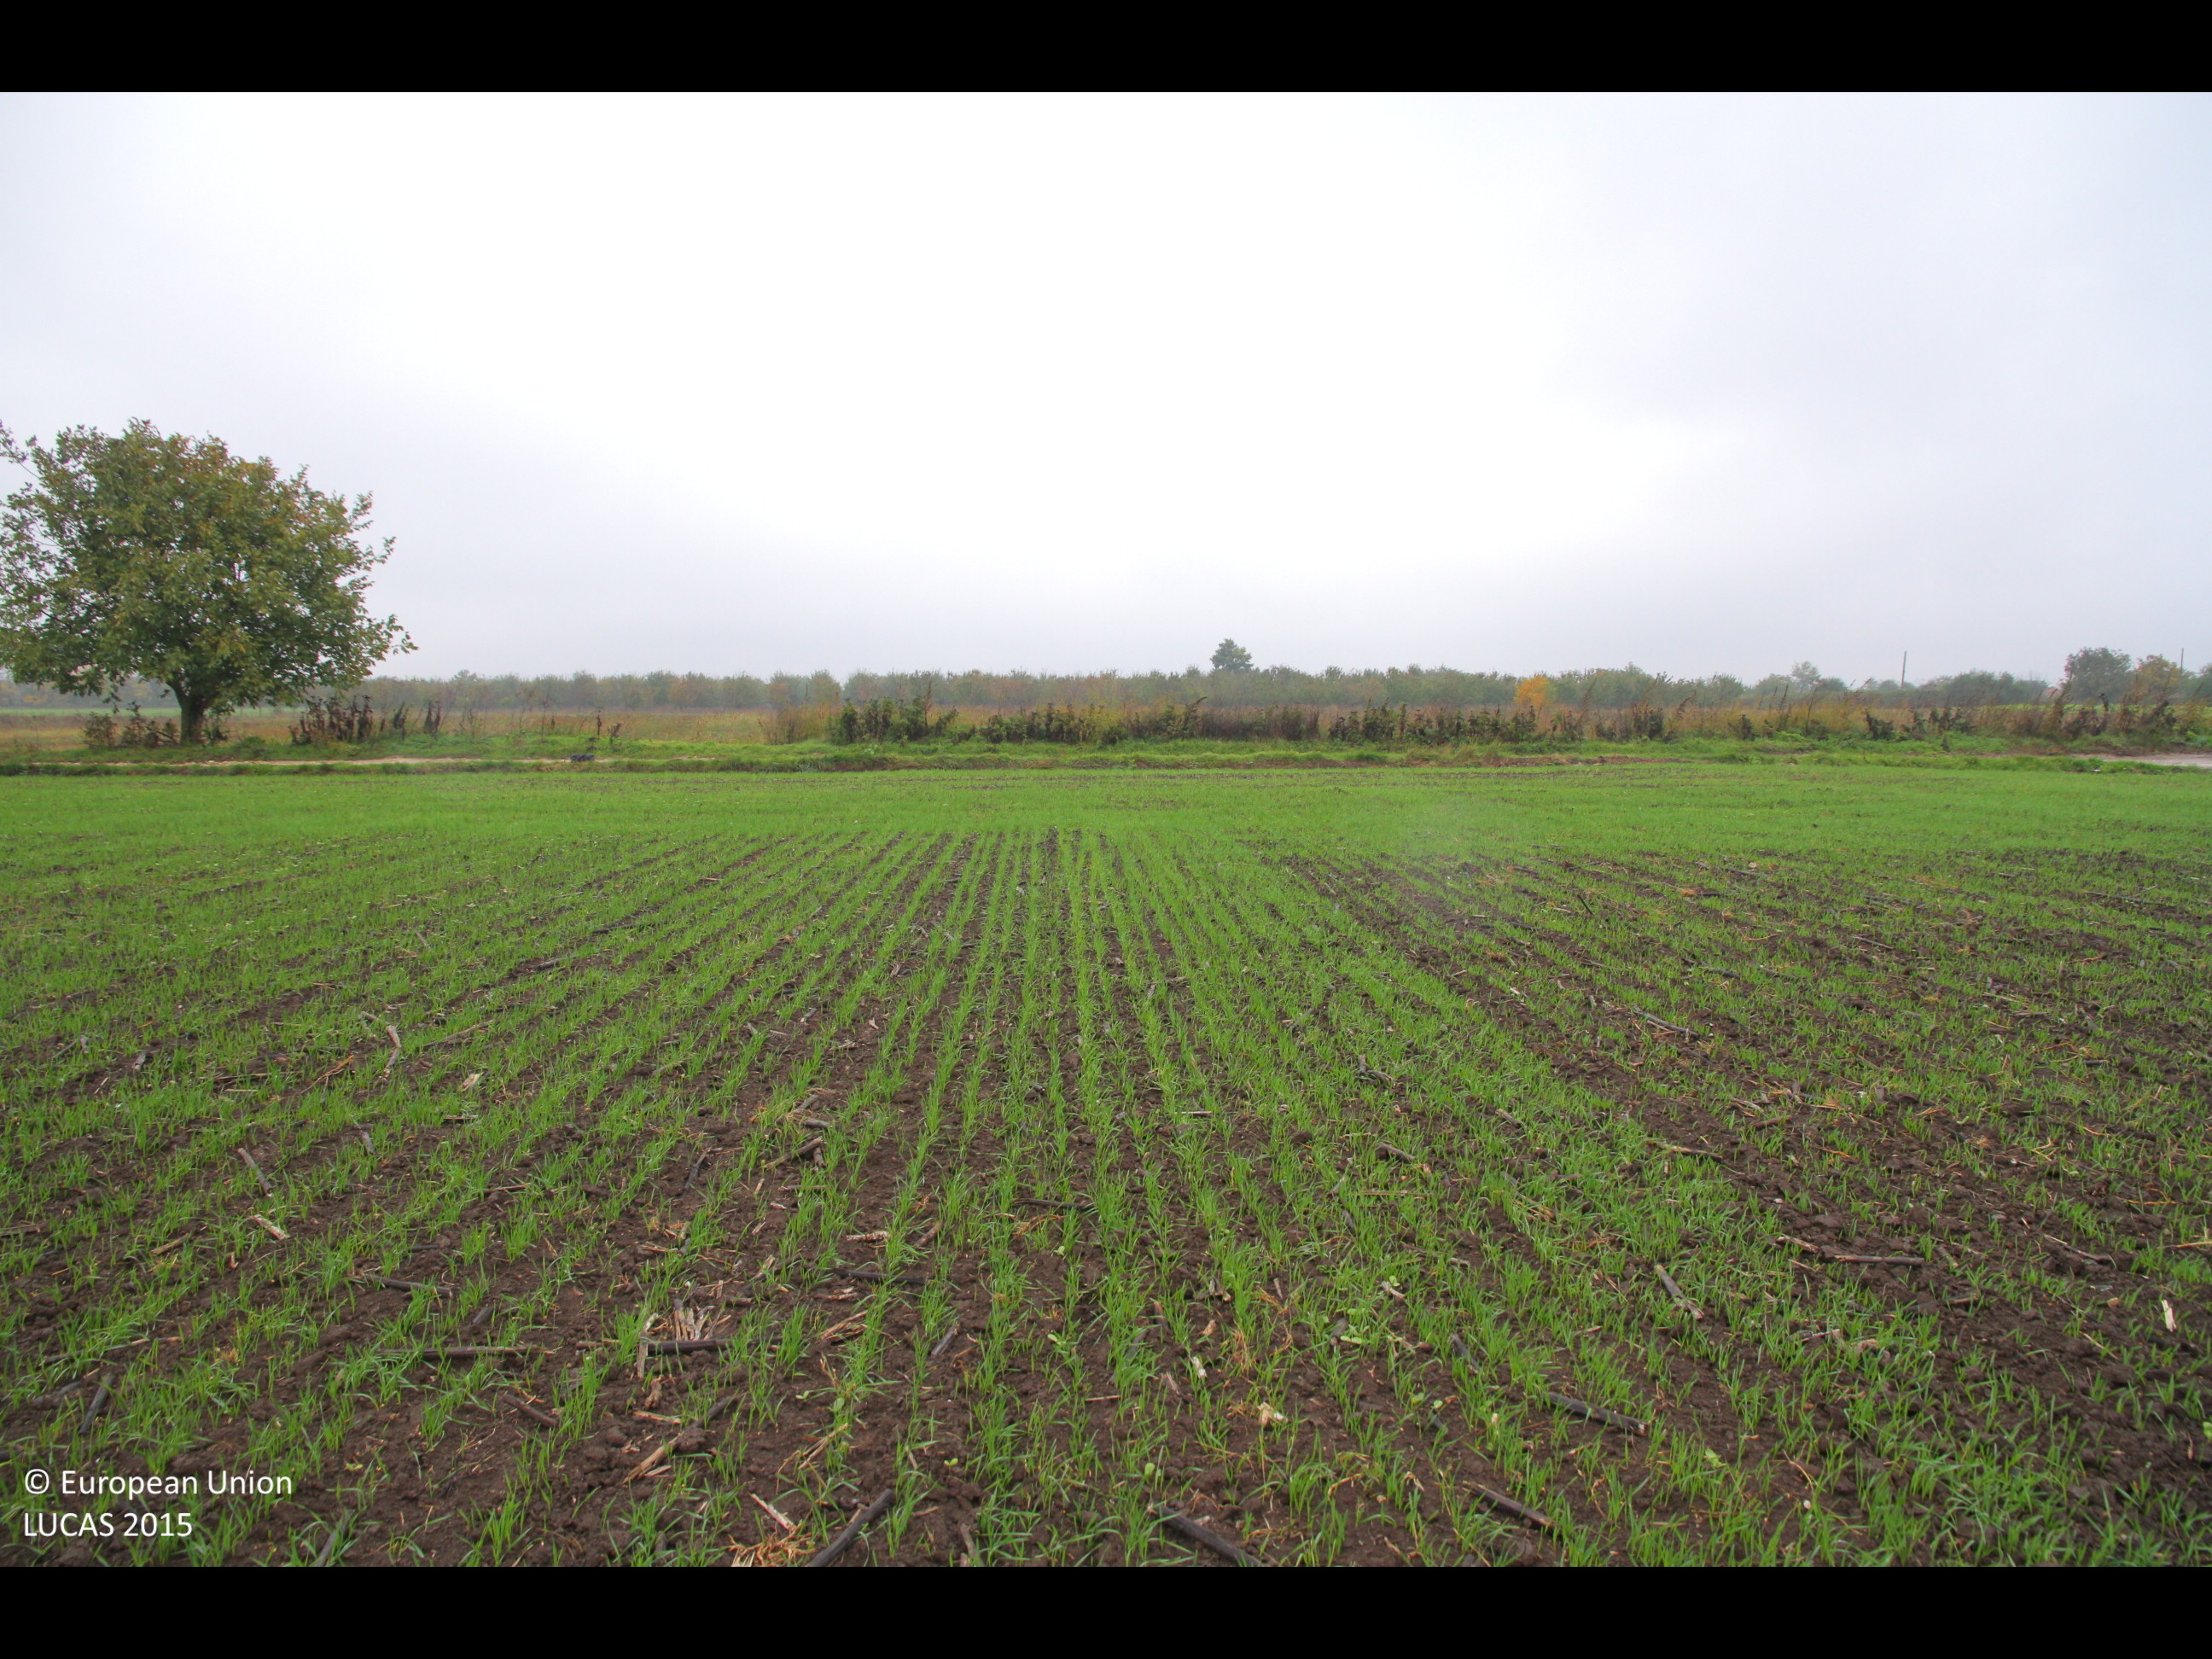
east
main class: Cropland
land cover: Common wheat
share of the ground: 25 - 50 %
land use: Agriculture (excluding fallow land and kitchen gardens)
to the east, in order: Common wheat; Grass margins; Paved roads, cycling and walking lanes; Grass margins; Abandoned hedges; Other fresh vegetables; Lucerne; Grassland with sparse tree/shrub cover; Artificial constructions in urban areas; Maize
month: October
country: BG
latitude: 43.6714
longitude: 26.9994
